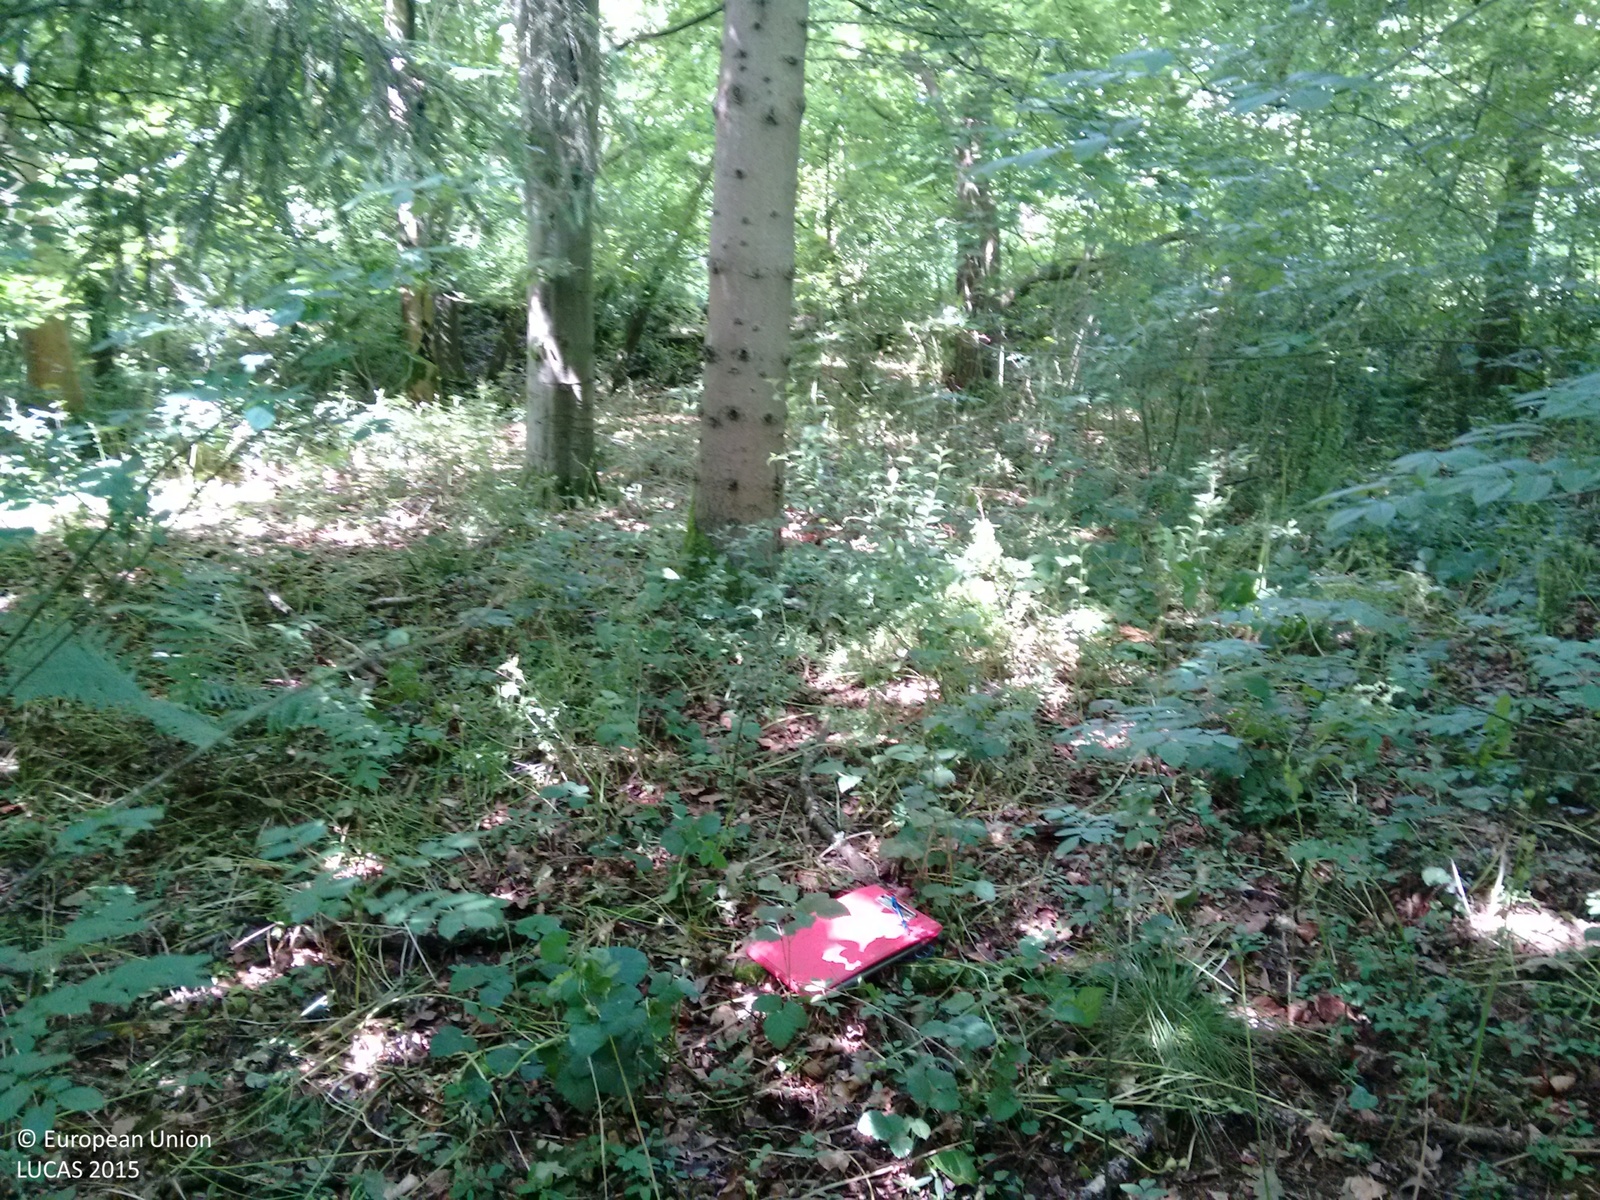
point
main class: Woodland
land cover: Broadleaved woodland
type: mesophytic deciduous forest
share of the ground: > 75 %
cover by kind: broadleaved forest trees 80 %, coniferous forest trees 20 %
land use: Forestry
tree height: > 5 m
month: June
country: GB
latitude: 51.3429
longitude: -2.2215
